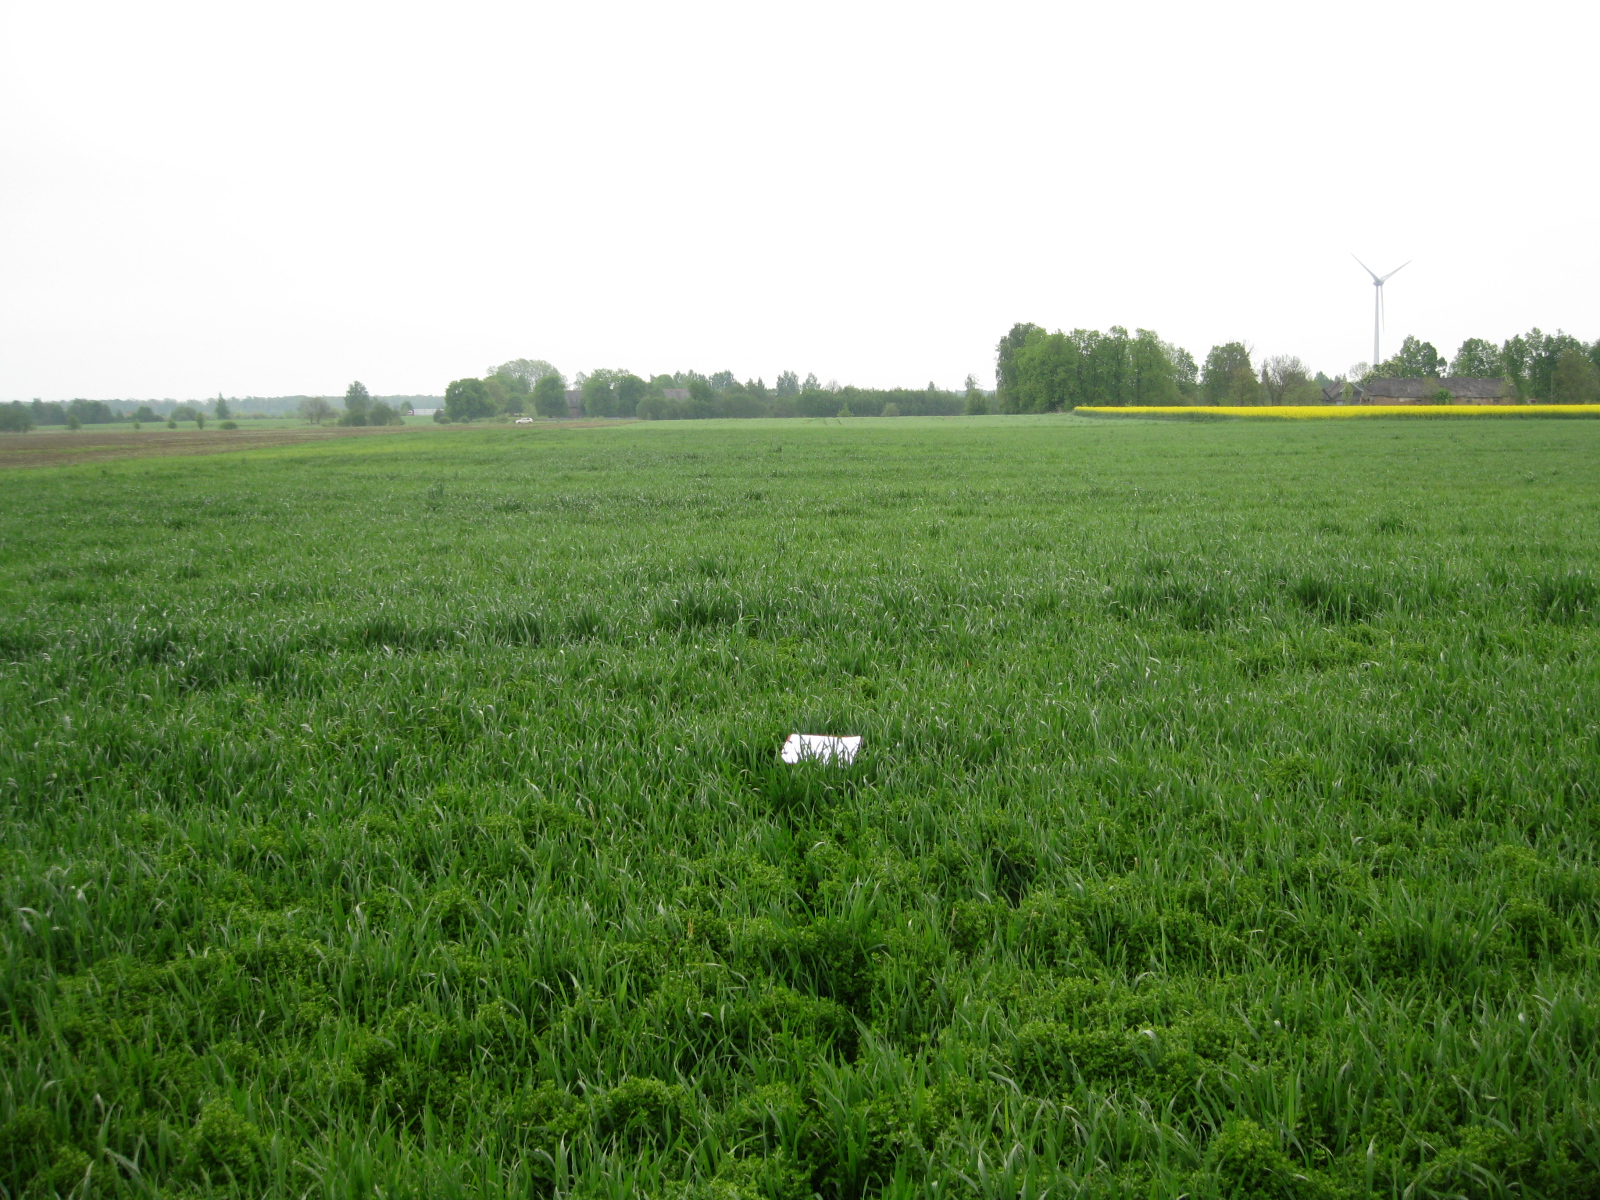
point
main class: Cropland
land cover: Common wheat
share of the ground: > 75 %
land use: Agriculture (excluding fallow land and kitchen gardens)
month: May
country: LT
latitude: 56.0116
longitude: 23.8951
